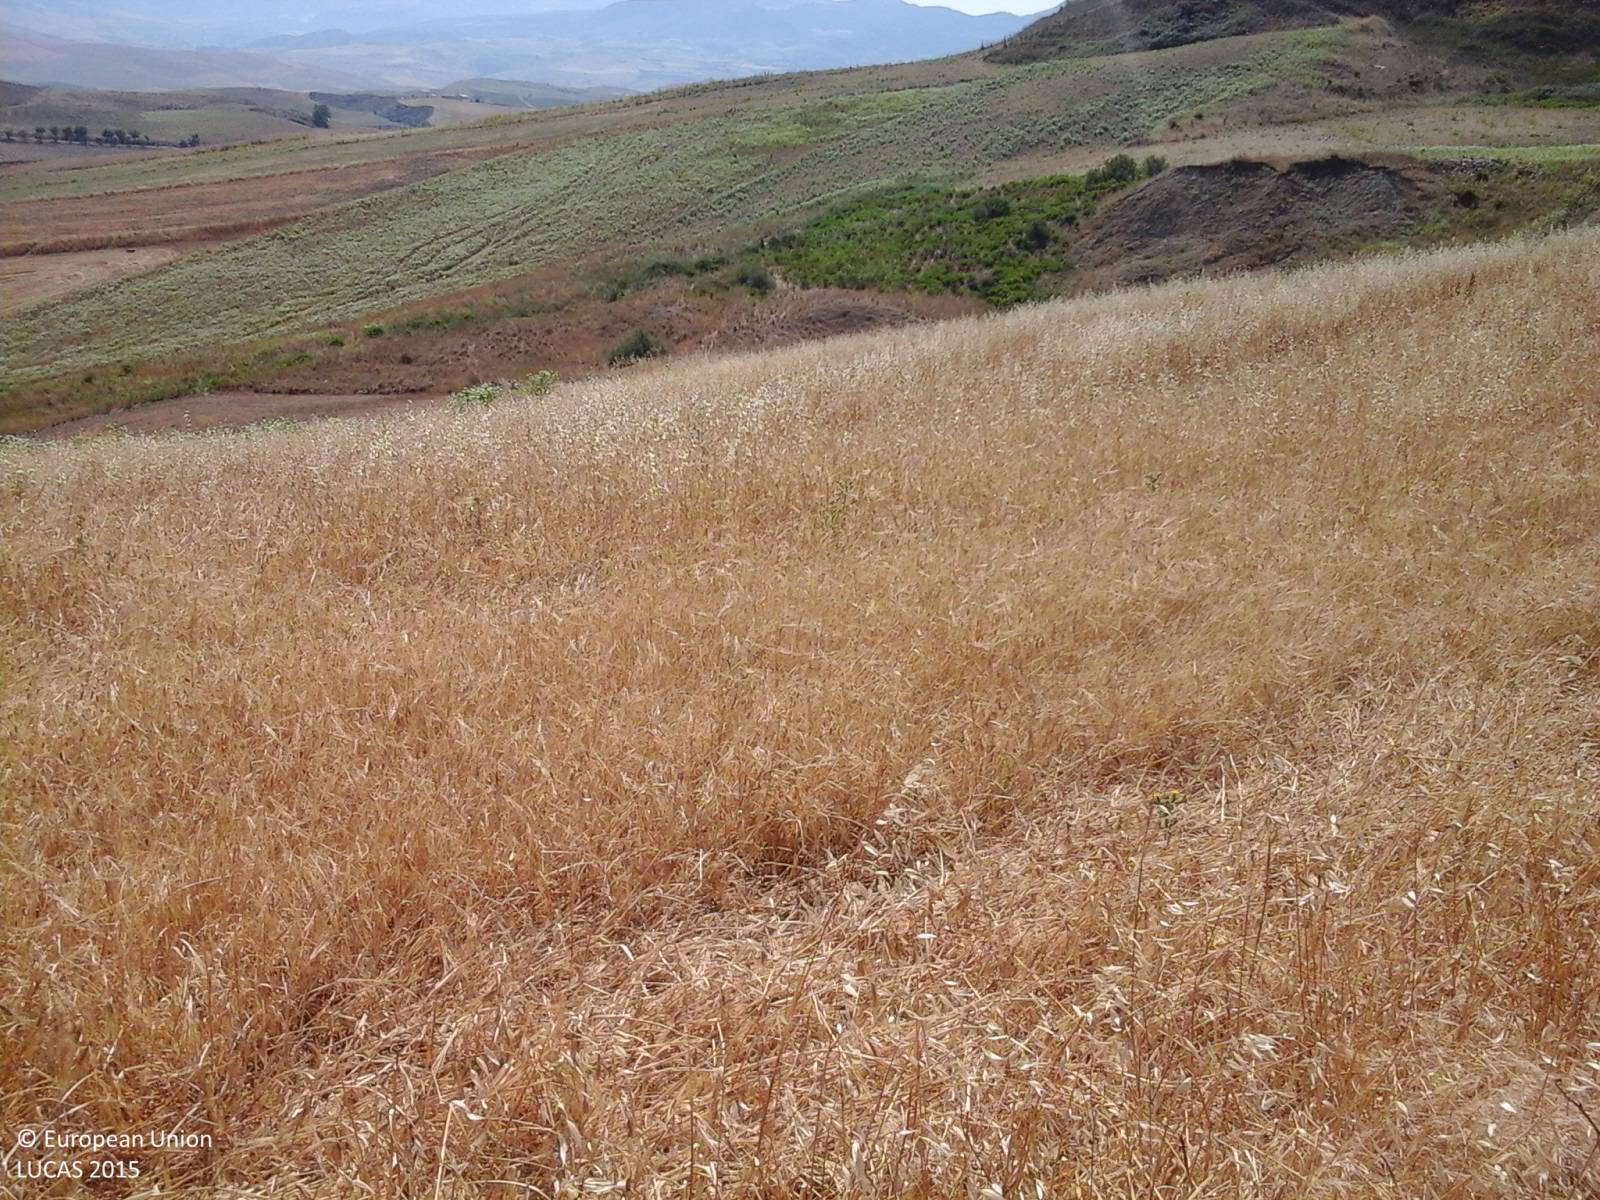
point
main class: Cropland
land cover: Barley
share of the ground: > 75 %
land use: Agriculture (excluding fallow land and kitchen gardens)
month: July
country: IT
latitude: 37.7675
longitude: 13.1666
